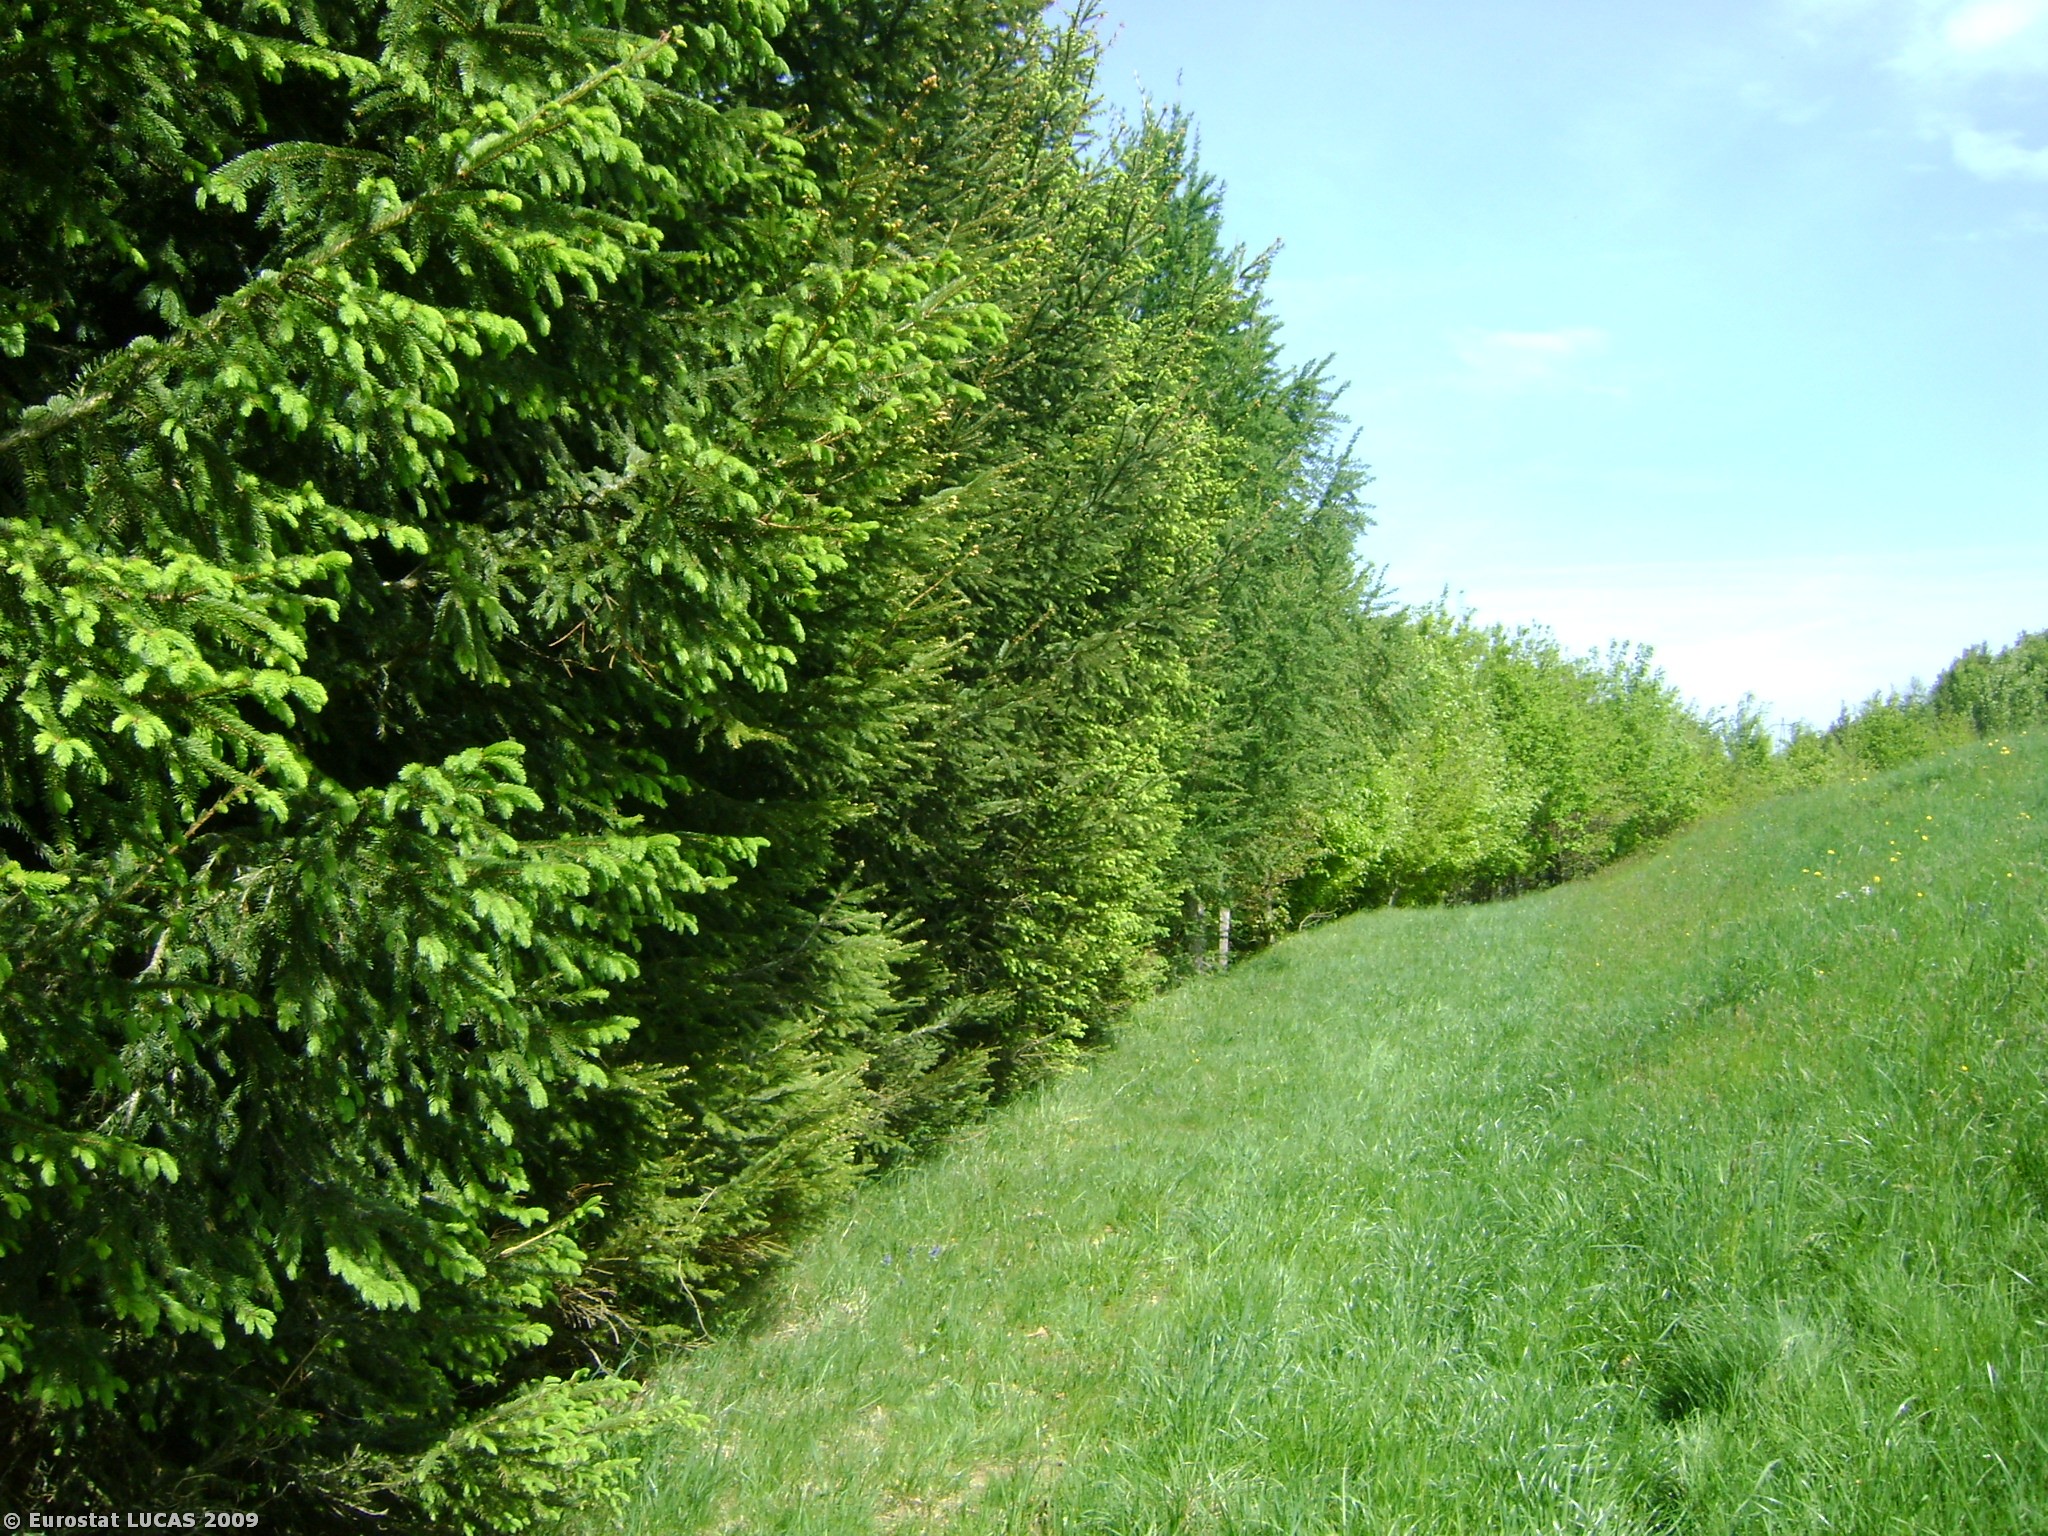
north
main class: Grassland
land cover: Grassland without tree/shrub cover
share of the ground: > 75 %
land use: Agriculture (excluding fallow land and kitchen gardens)
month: May
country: AT
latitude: 47.9243
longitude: 13.2241
